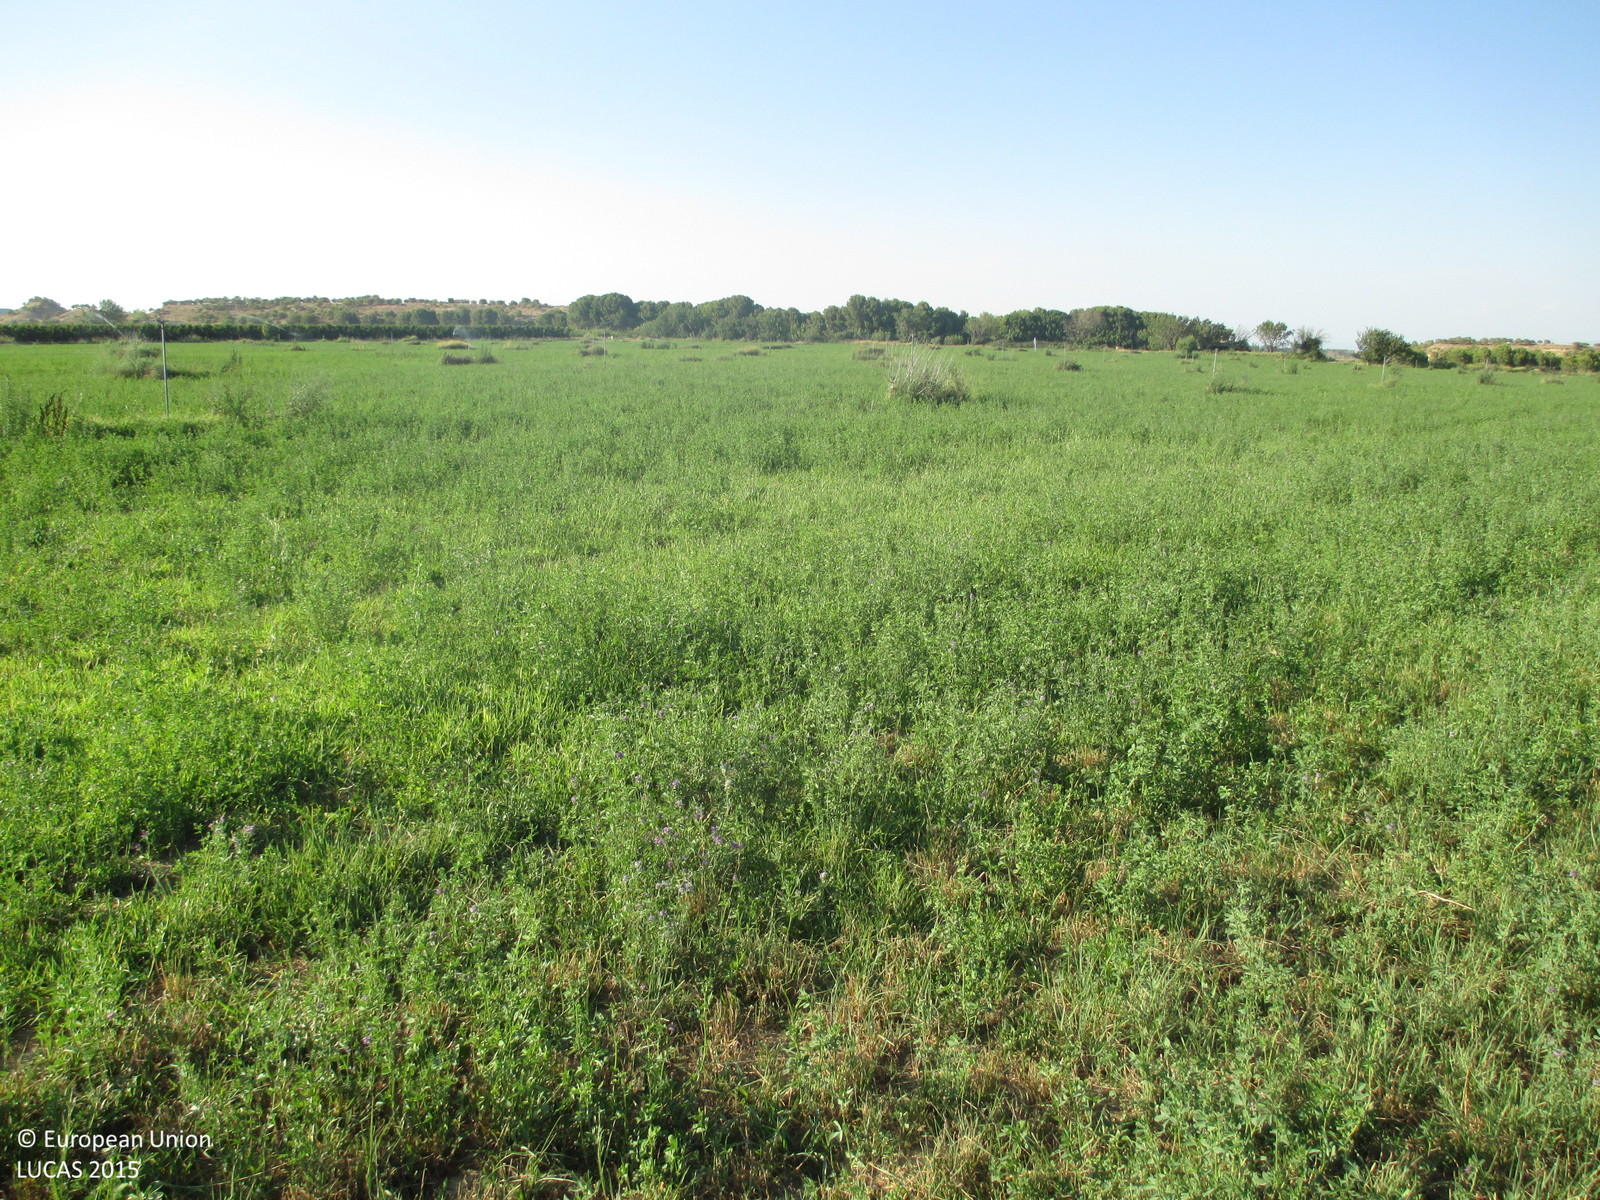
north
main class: Cropland
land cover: Lucerne
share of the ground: > 75 %
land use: Agriculture (excluding fallow land and kitchen gardens)
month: July
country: ES
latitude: 41.8354
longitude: 0.0484
